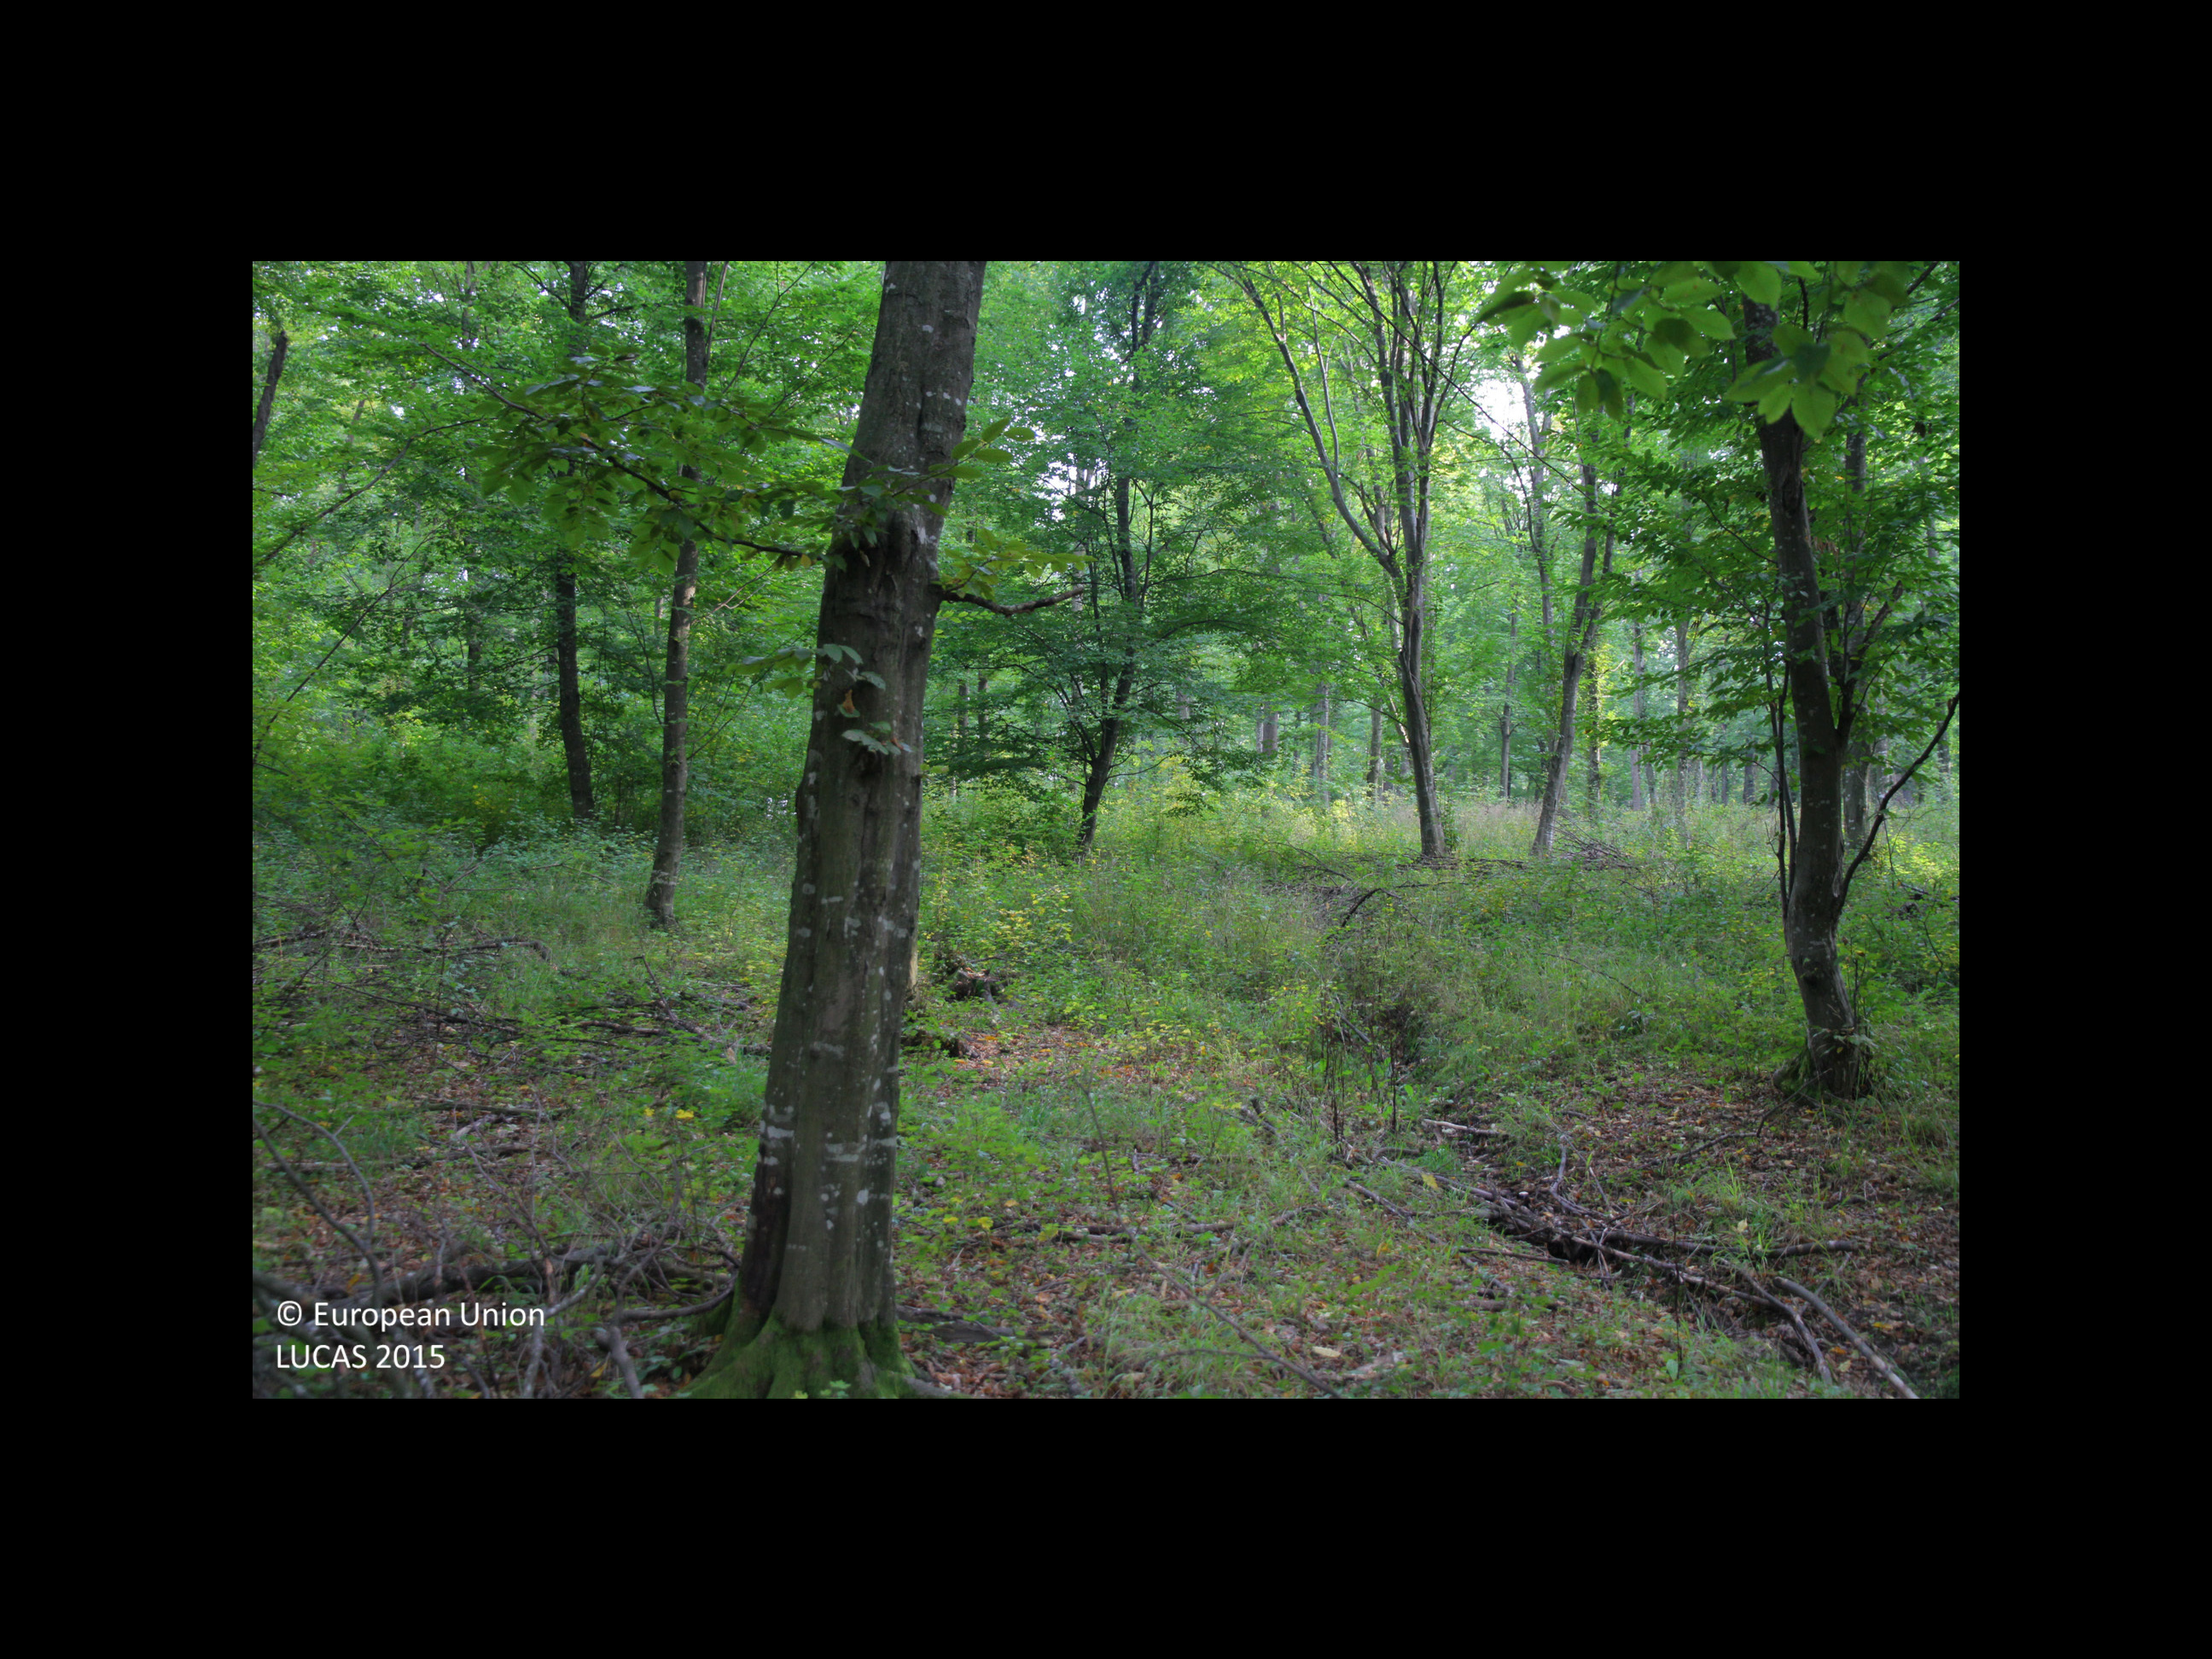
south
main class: Woodland
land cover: Broadleaved woodland
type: mesophytic deciduous forest
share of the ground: > 75 %
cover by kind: broadleaved forest trees 95 %, shrubs 5 %
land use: Forestry
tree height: > 5 m
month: October
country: BG
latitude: 43.5675
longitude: 27.0701
